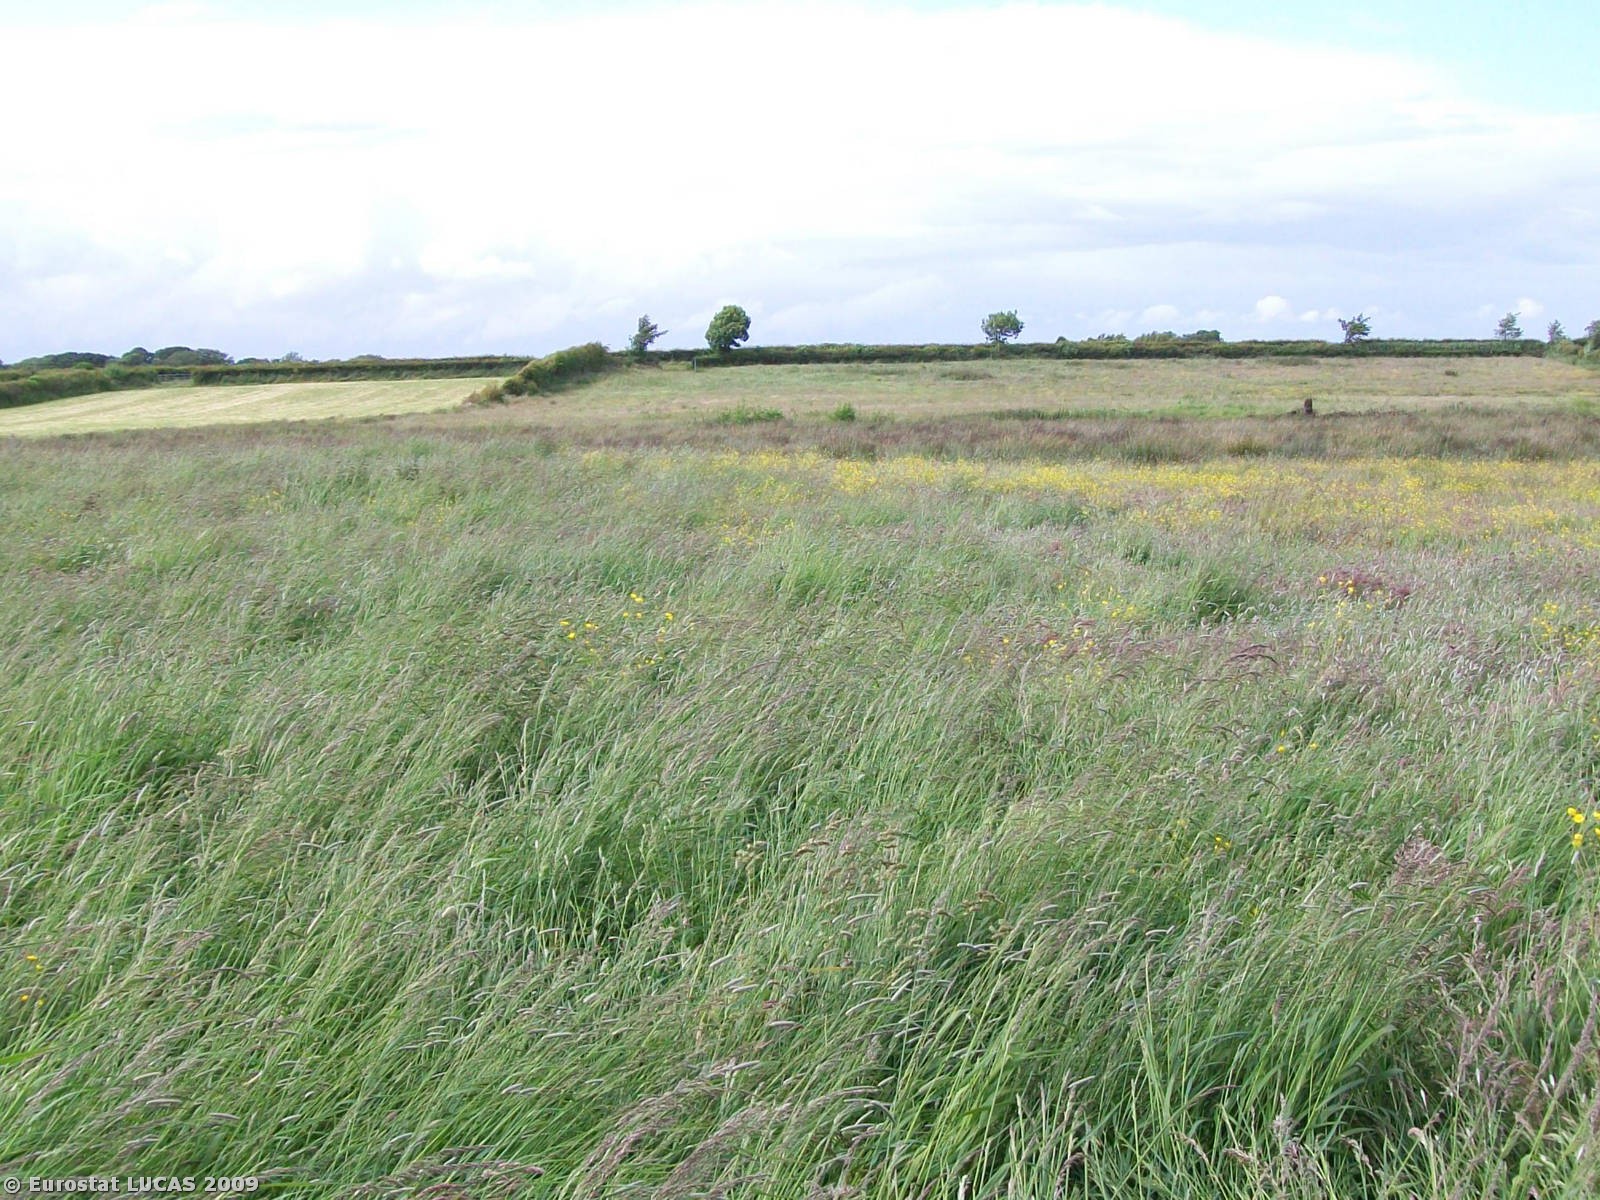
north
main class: Grassland
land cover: Grassland without tree/shrub cover
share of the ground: > 75 %
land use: Agriculture (excluding fallow land and kitchen gardens)
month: June
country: GB
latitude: 54.8448
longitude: -3.2033
